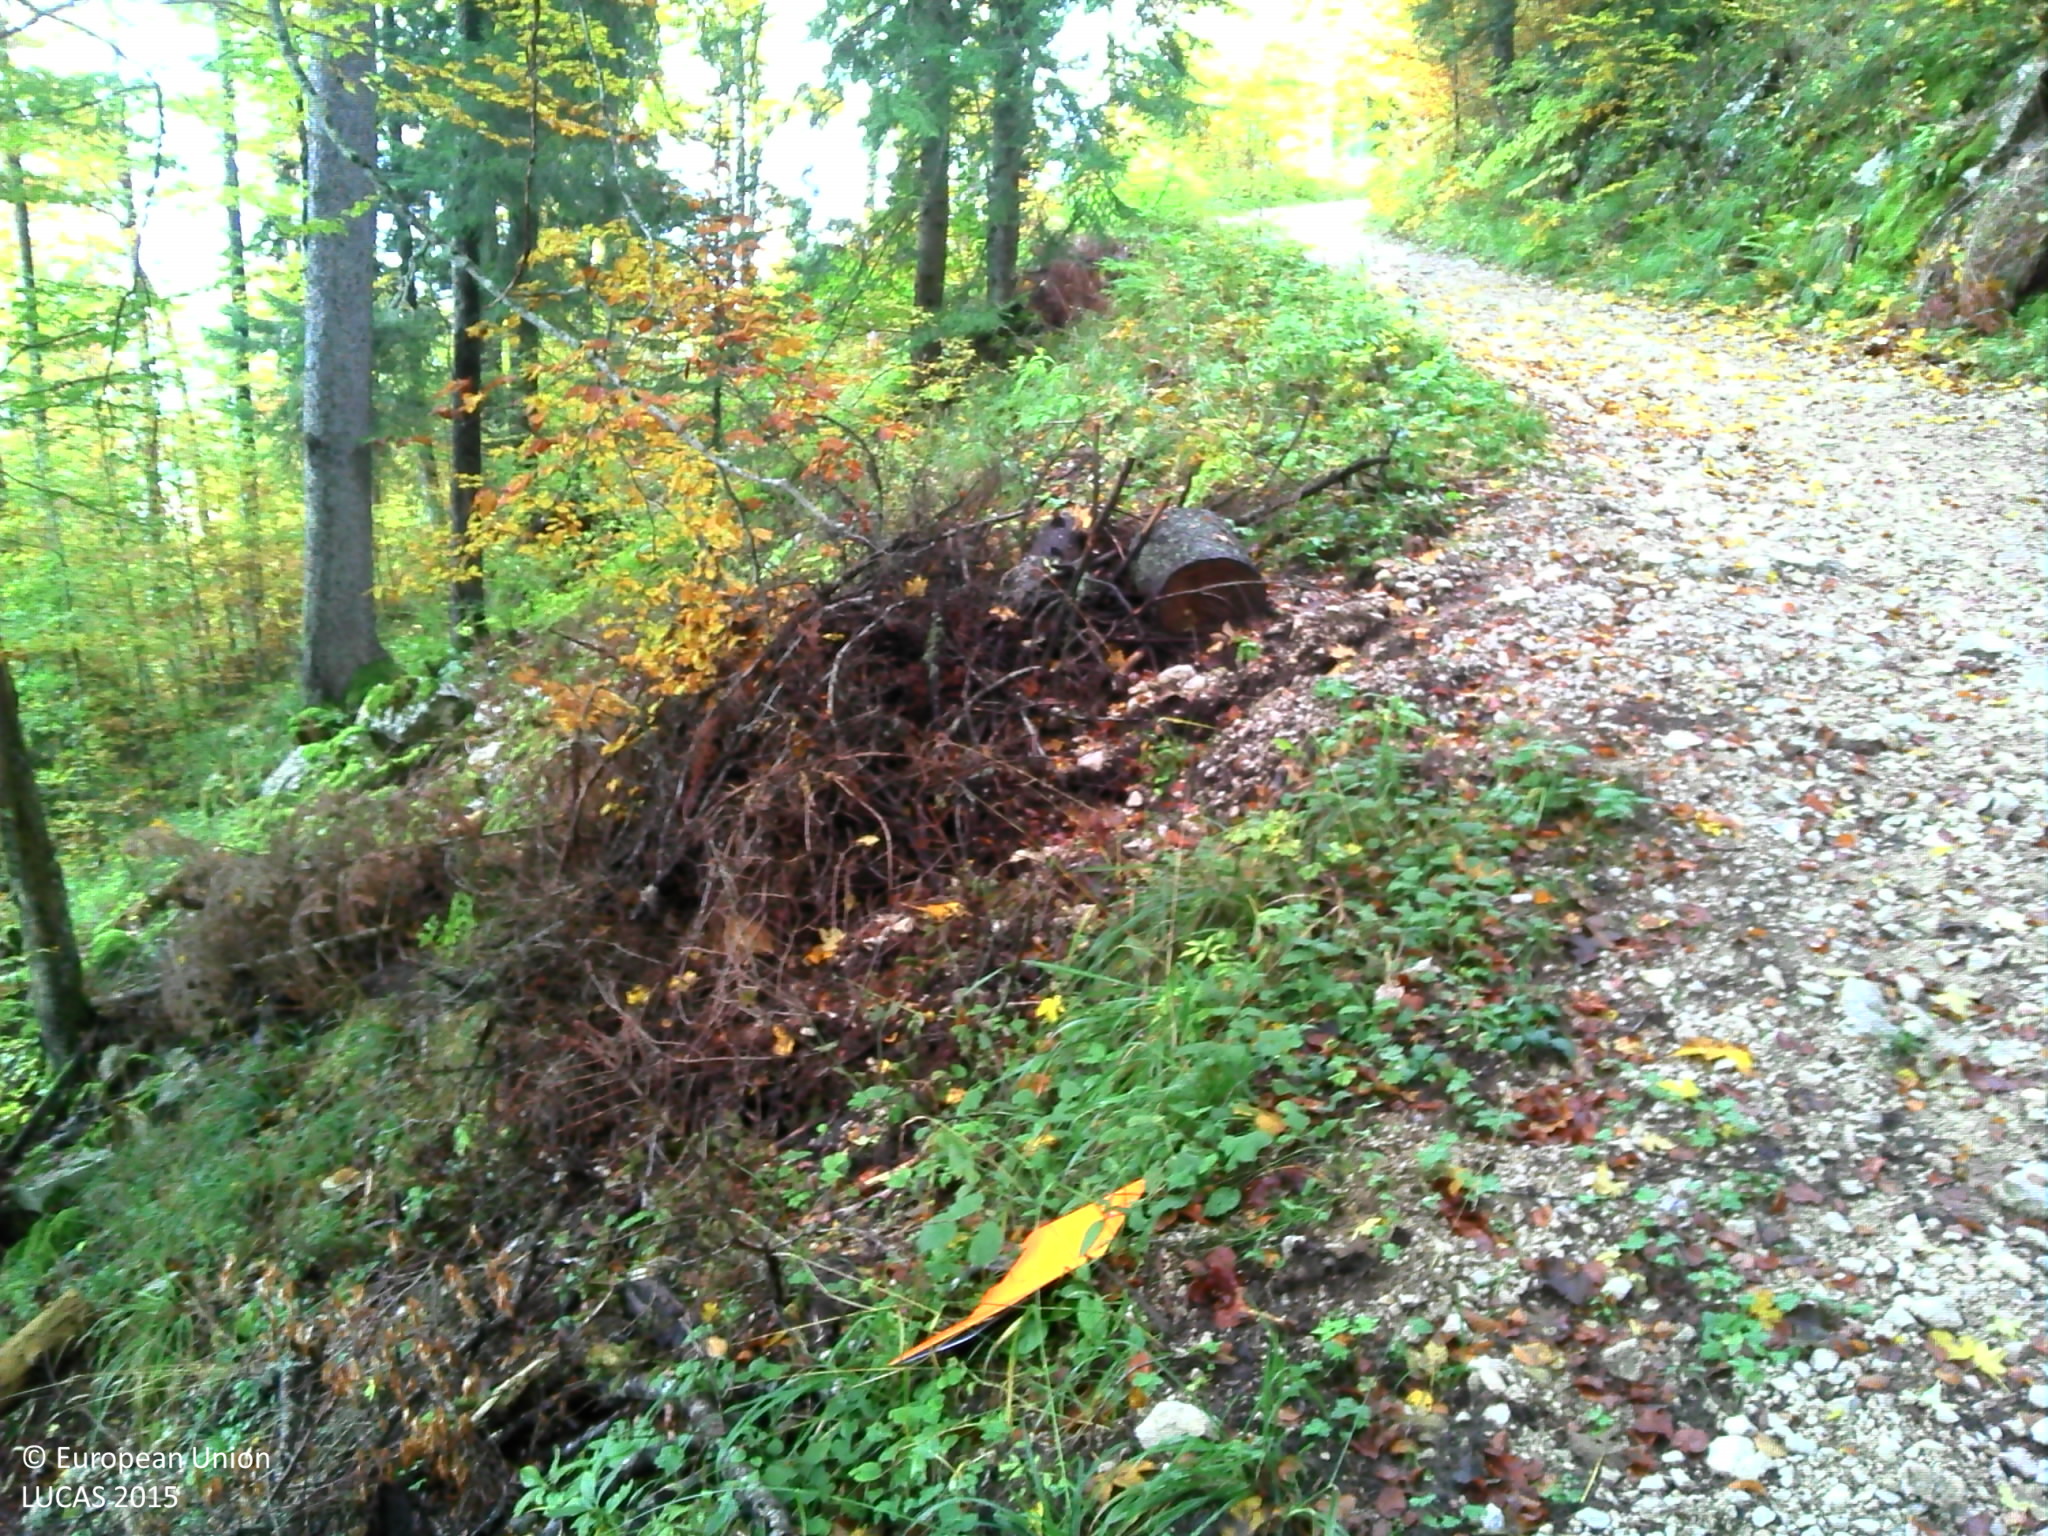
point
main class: Woodland
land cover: Spruce dominated mixed woodland
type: mountainous beech forest
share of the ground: > 75 %
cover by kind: coniferous forest trees 60 %, broadleaved forest trees 40 %
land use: Forestry
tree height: > 5 m
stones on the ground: 10 - 25 %
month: October
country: FR
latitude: 46.7577
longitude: 6.3499
